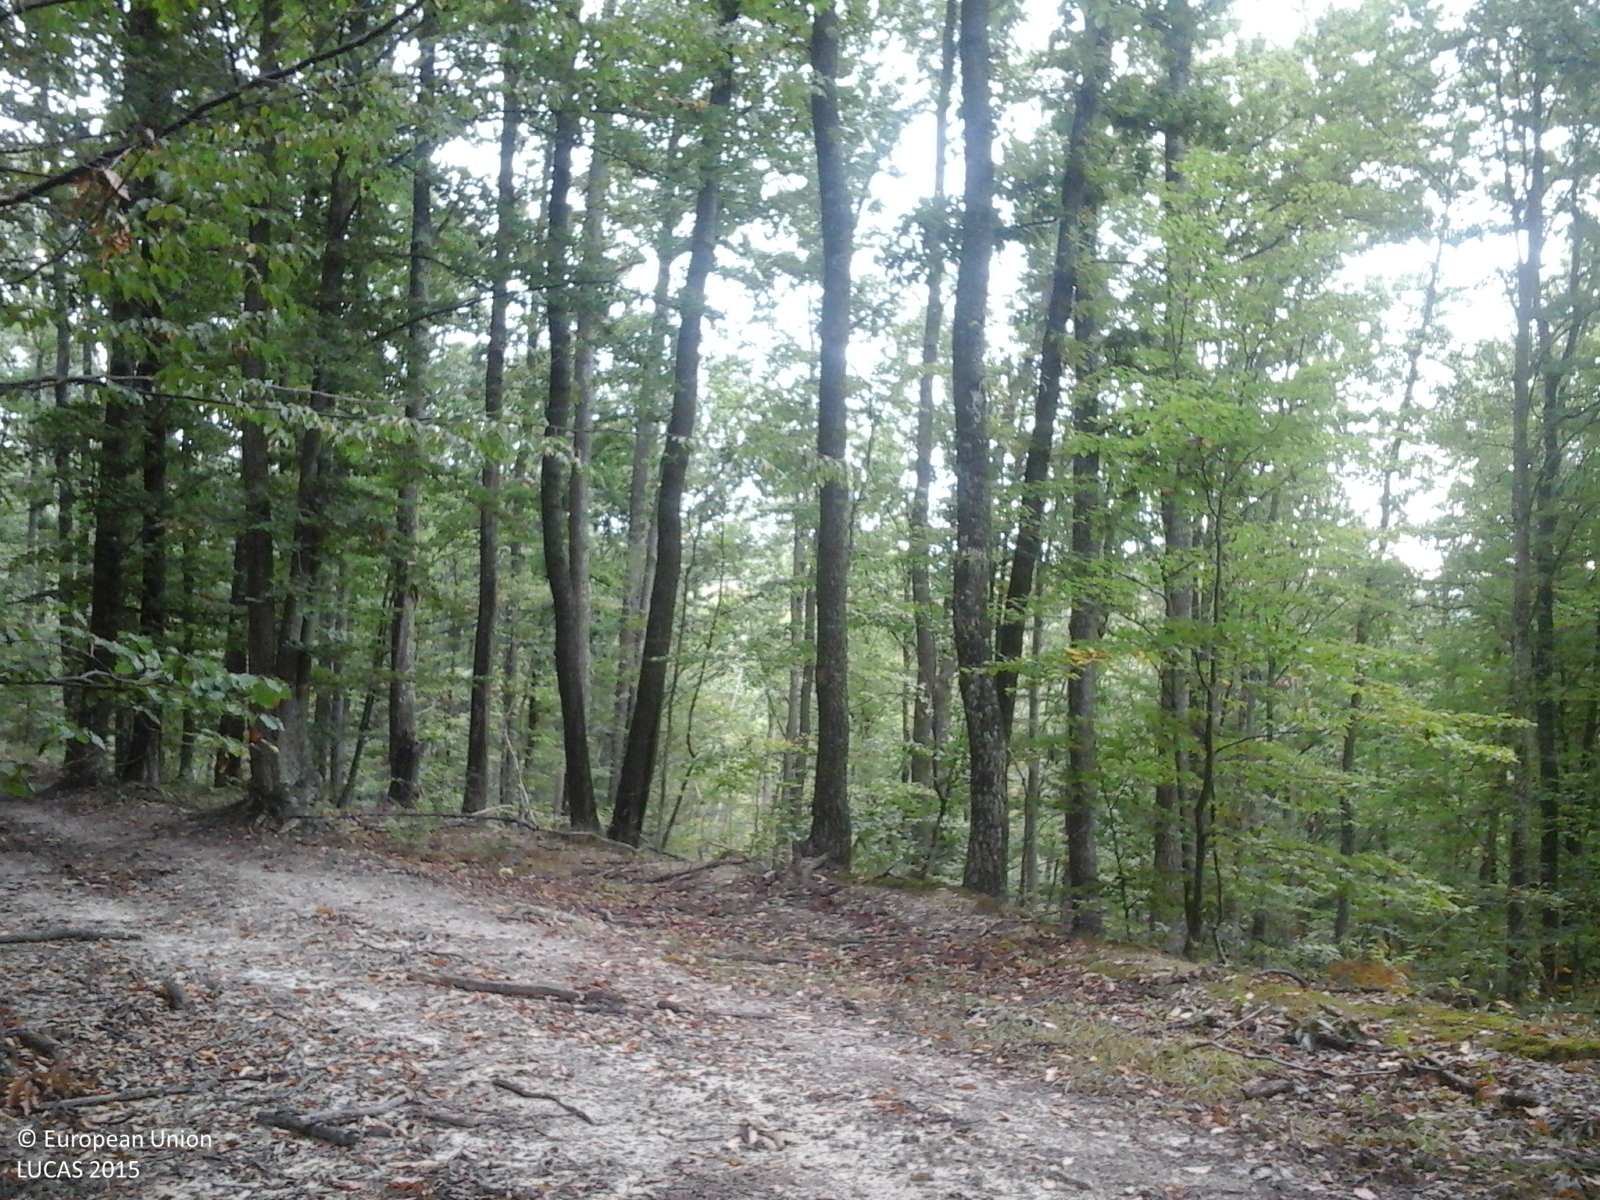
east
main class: Woodland
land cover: Broadleaved woodland
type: beech forest
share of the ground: > 75 %
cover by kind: broadleaved forest trees 100 %
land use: Forestry
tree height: > 5 m
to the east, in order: Broadleaved woodland; Tracks; Broadleaved woodland
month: September
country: RO
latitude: 45.7748
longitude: 22.2219
